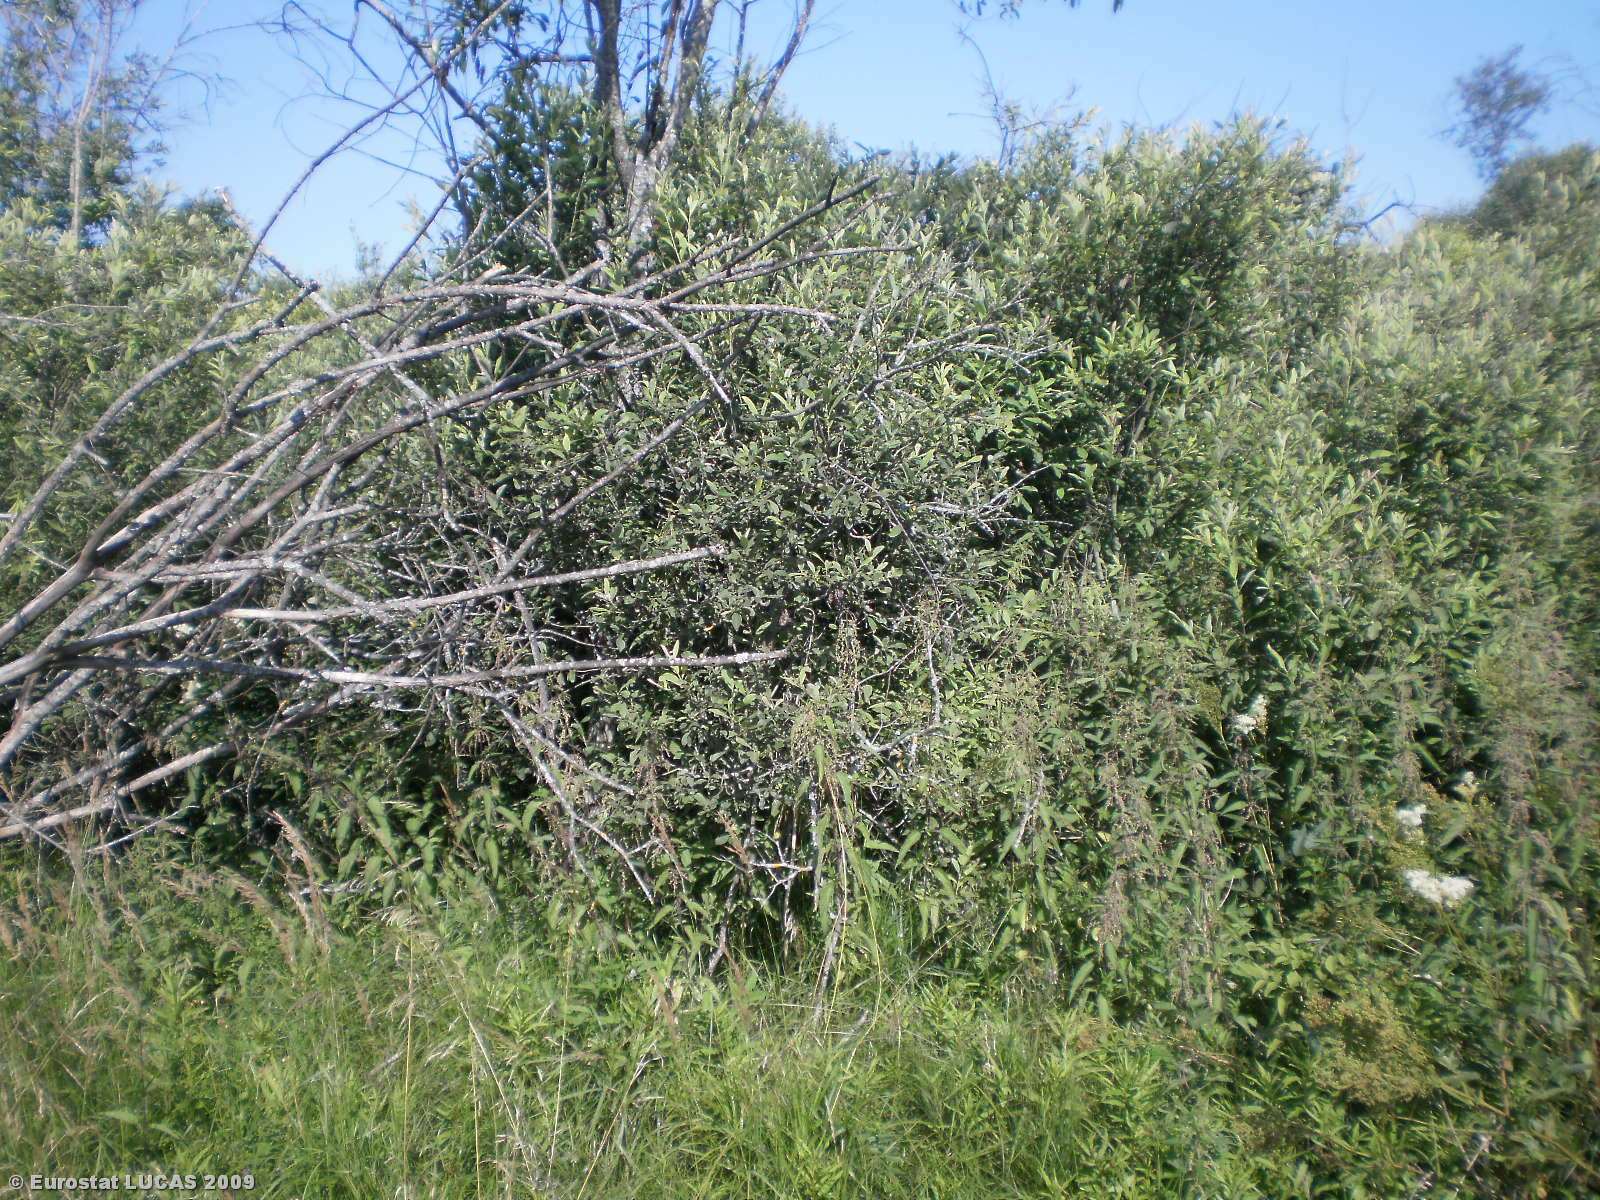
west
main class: Woodland
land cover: Broadleaved woodland
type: non-riverine alder, birch or aspen forest
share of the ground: > 75 %
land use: Forestry
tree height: > 5 m
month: July
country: LT
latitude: 56.0039
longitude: 25.8307
